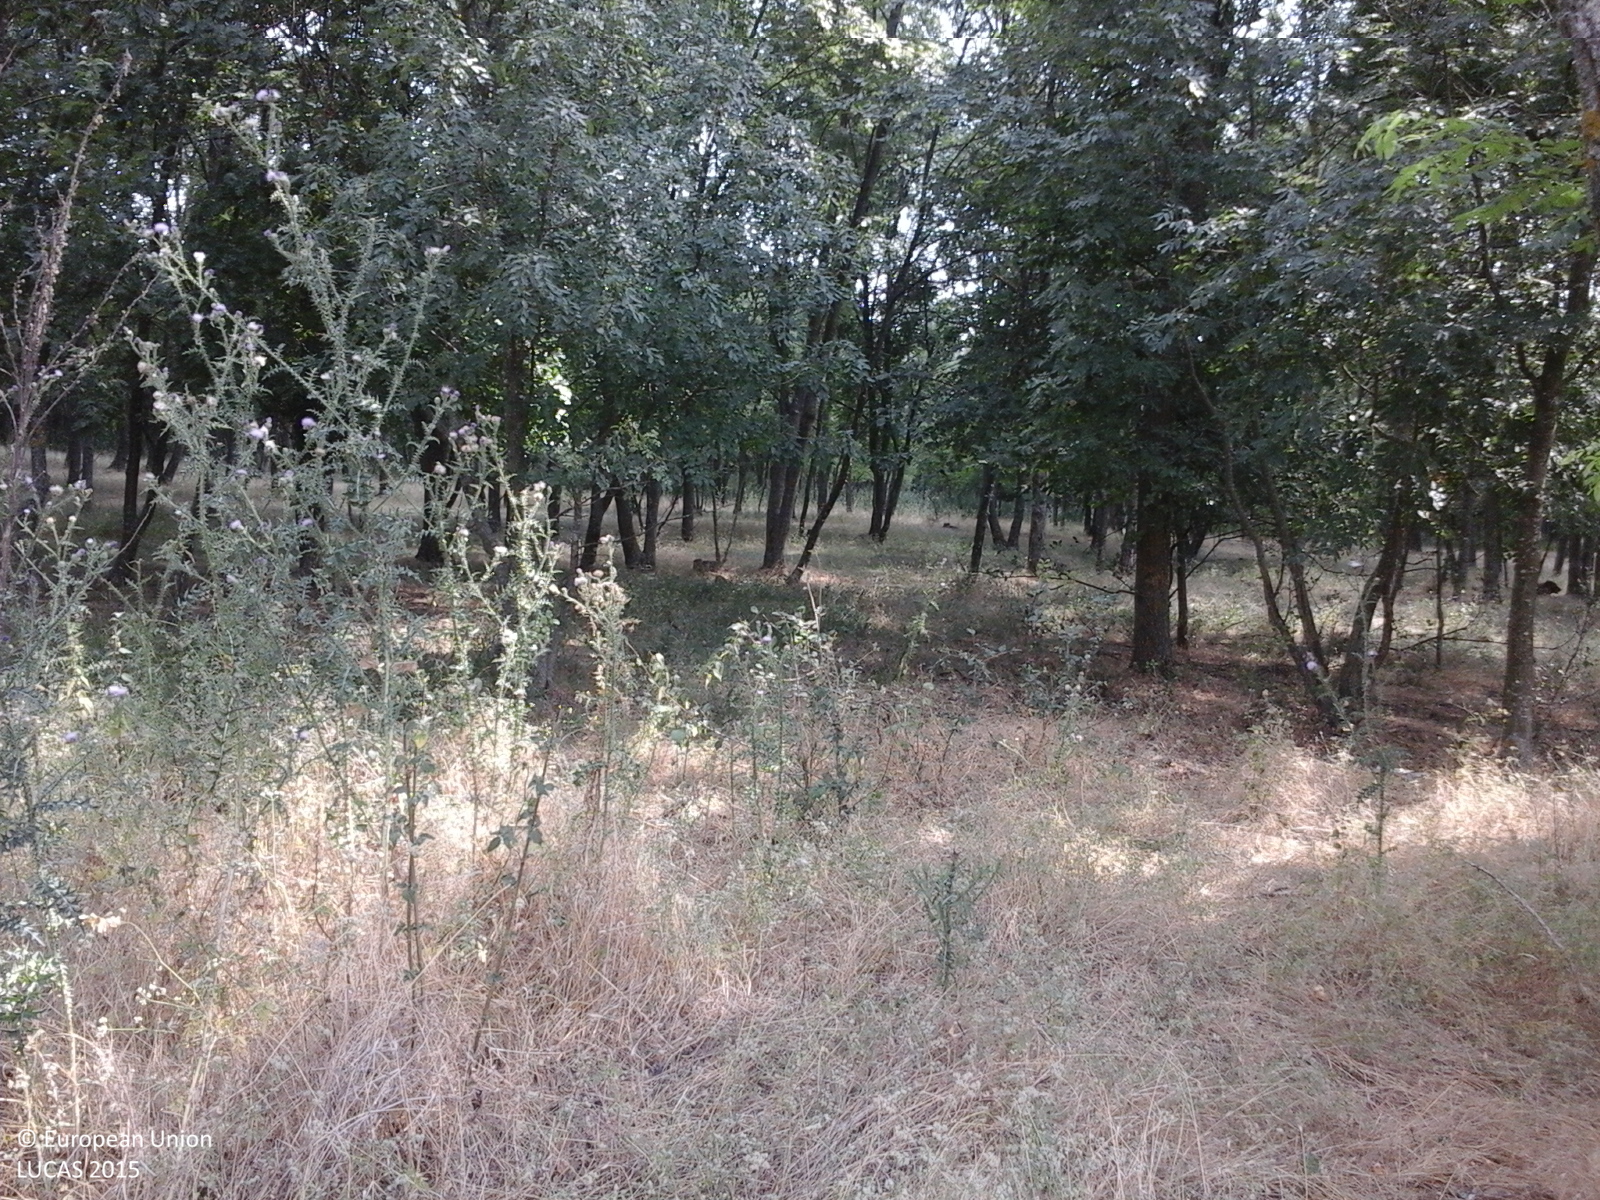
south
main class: Woodland
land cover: Broadleaved woodland
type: mesophytic deciduous forest
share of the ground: > 75 %
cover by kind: broadleaved forest trees 85 %, herbaceous plants 15 %
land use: Forestry
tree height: > 5 m
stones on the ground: 10 - 25 %
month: July
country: RO
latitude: 44.9816
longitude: 28.3737
